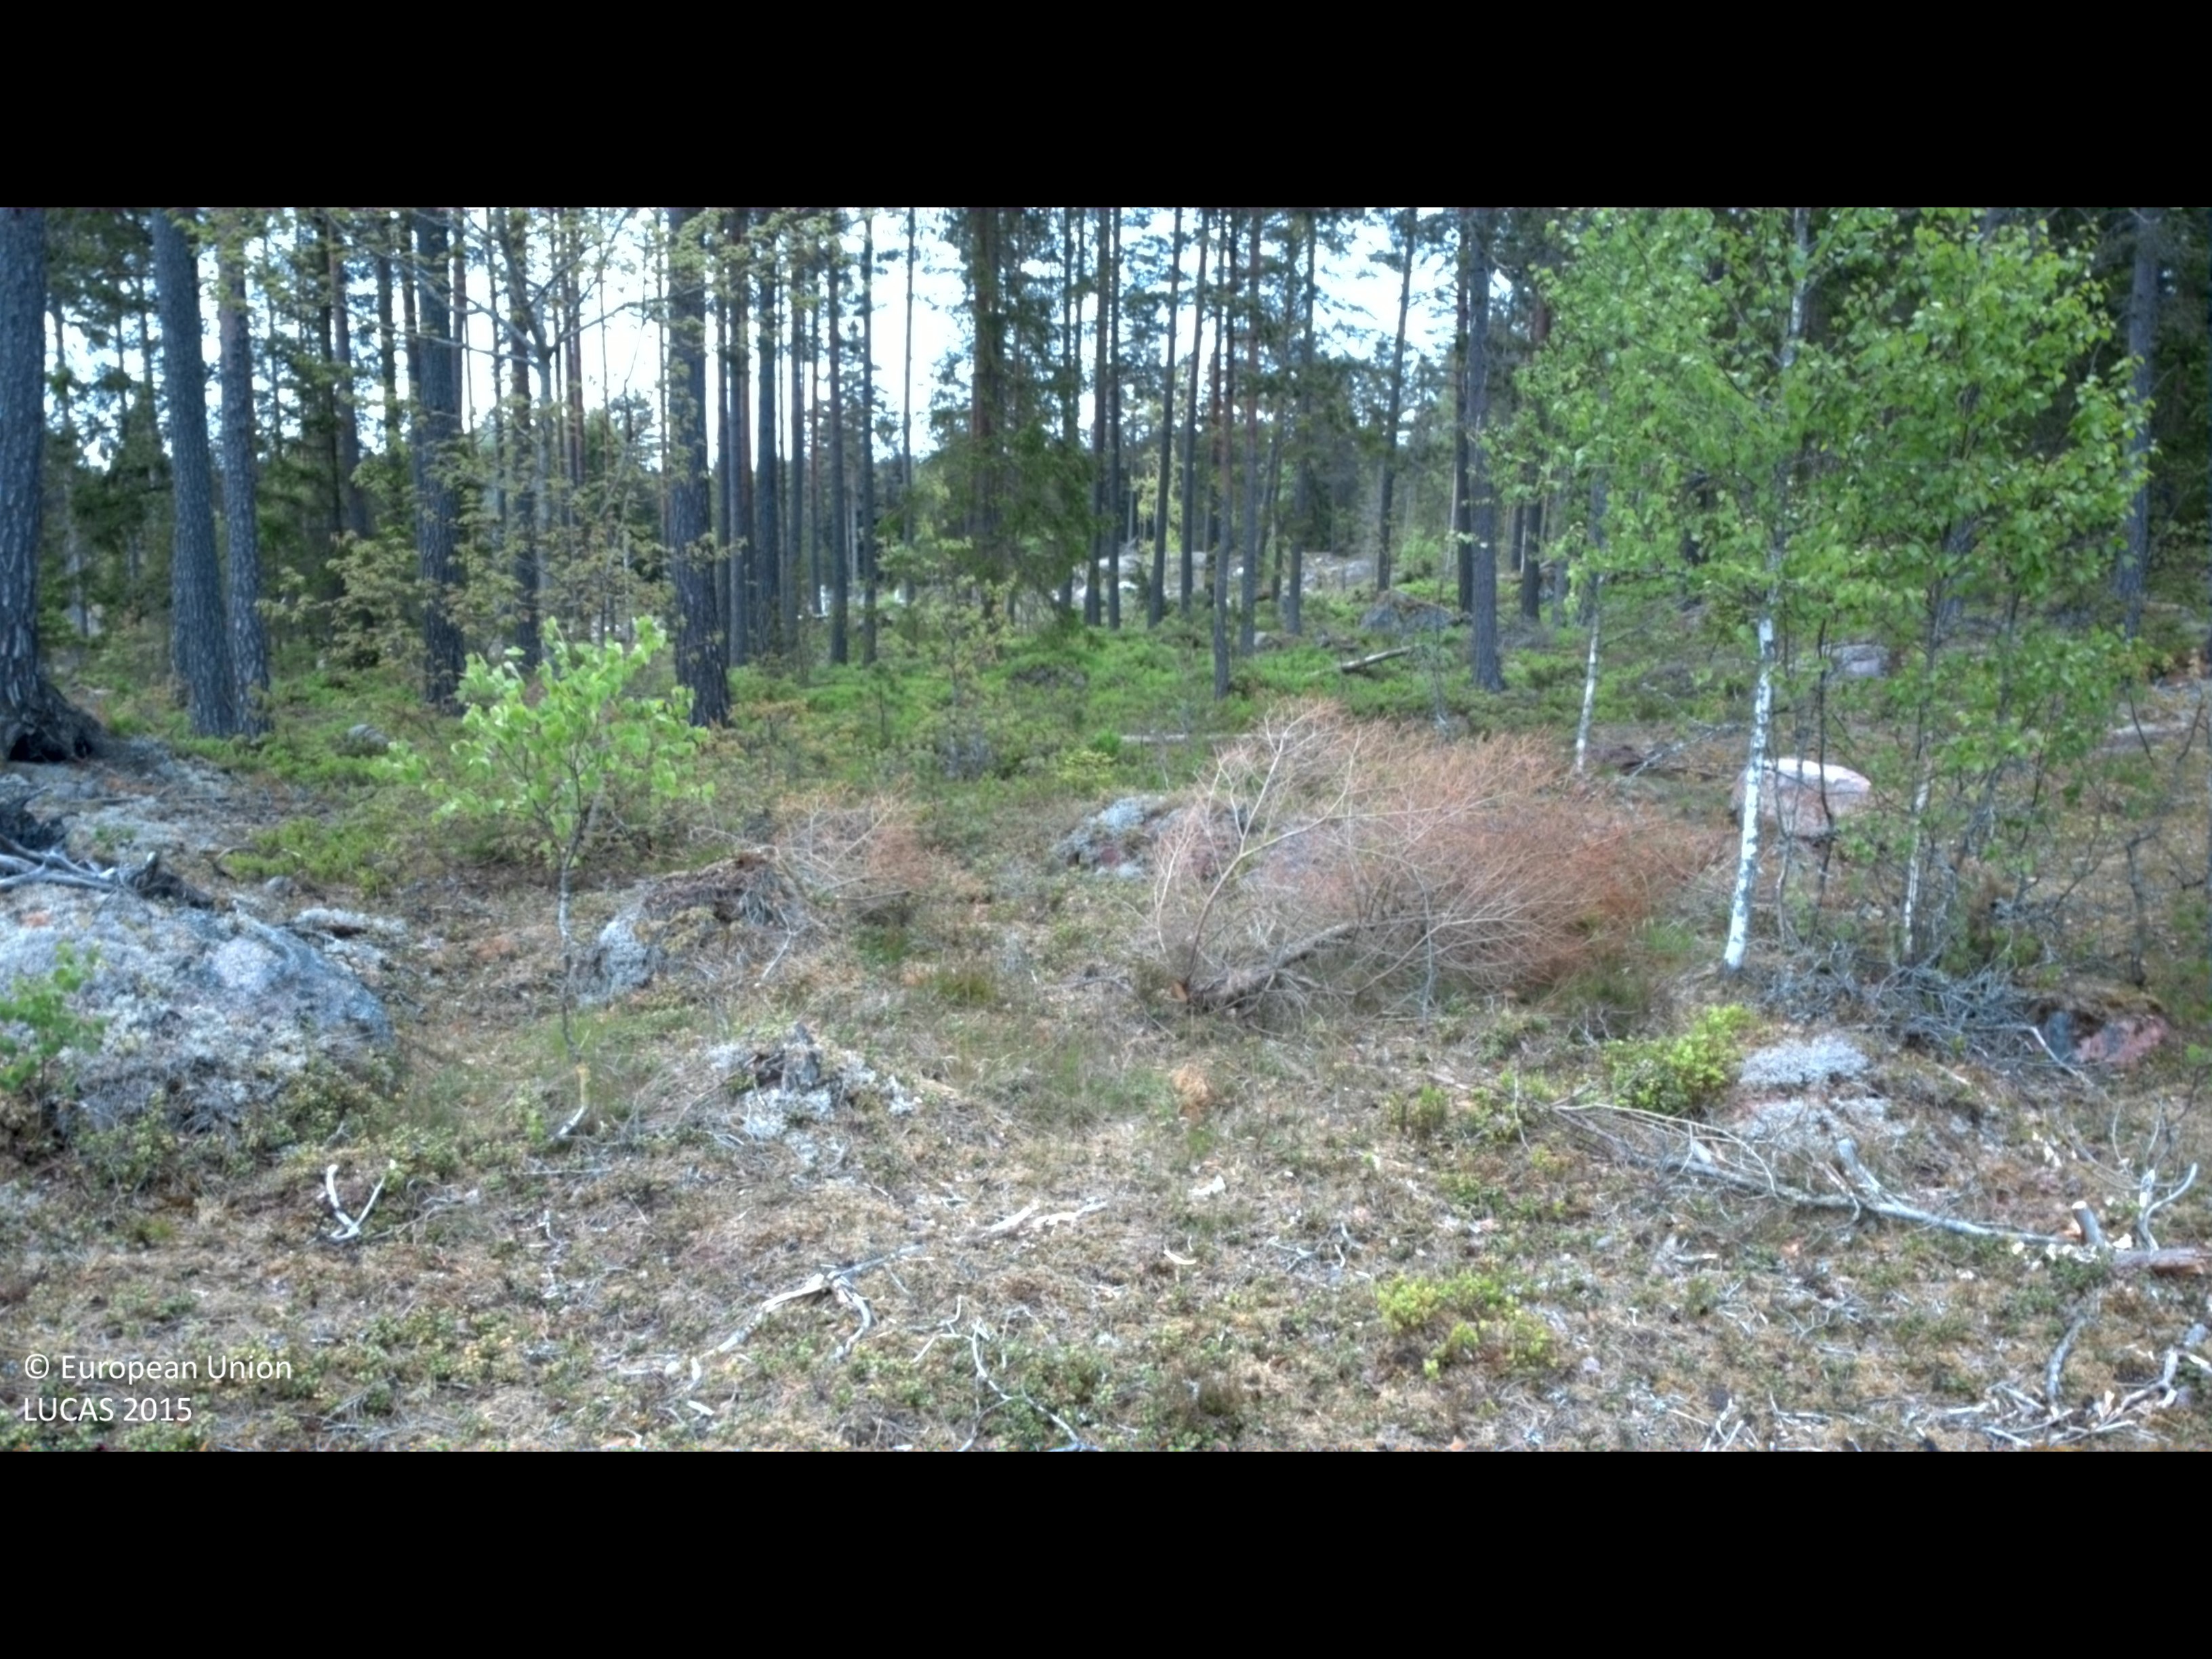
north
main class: Woodland
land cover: Pine dominated coniferous woodland
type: boreal forest
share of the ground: 10 - 25 %
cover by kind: lichens and mosses 45 %, shrubs 35 %, coniferous forest trees 15 %, broadleaved forest trees 5 %
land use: Forestry
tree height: > 5 m
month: May
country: SE
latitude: 57.4801
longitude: 16.2194
